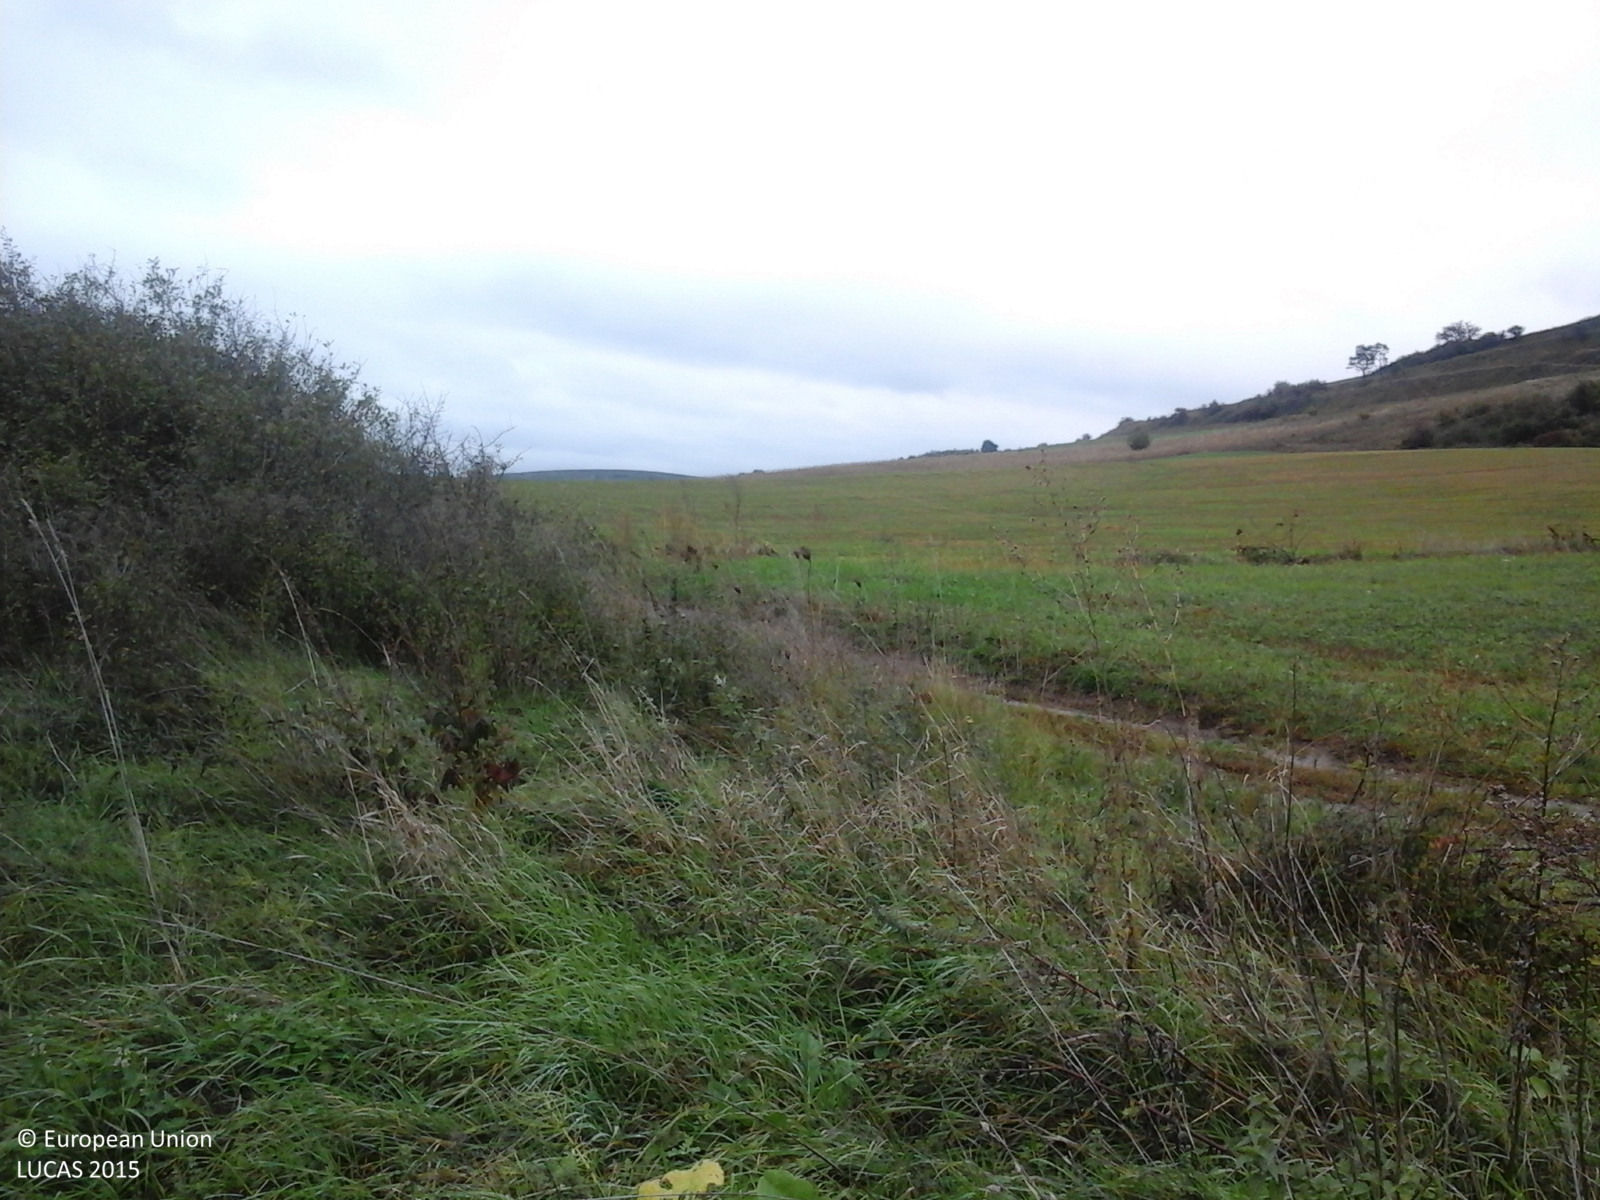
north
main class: Grassland
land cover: Spontaneously vegetated surfaces
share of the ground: > 75 %
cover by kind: herbaceous plants 100 %
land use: Fallow land
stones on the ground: < 10 %
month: October
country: RO
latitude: 45.8225
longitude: 24.1695
